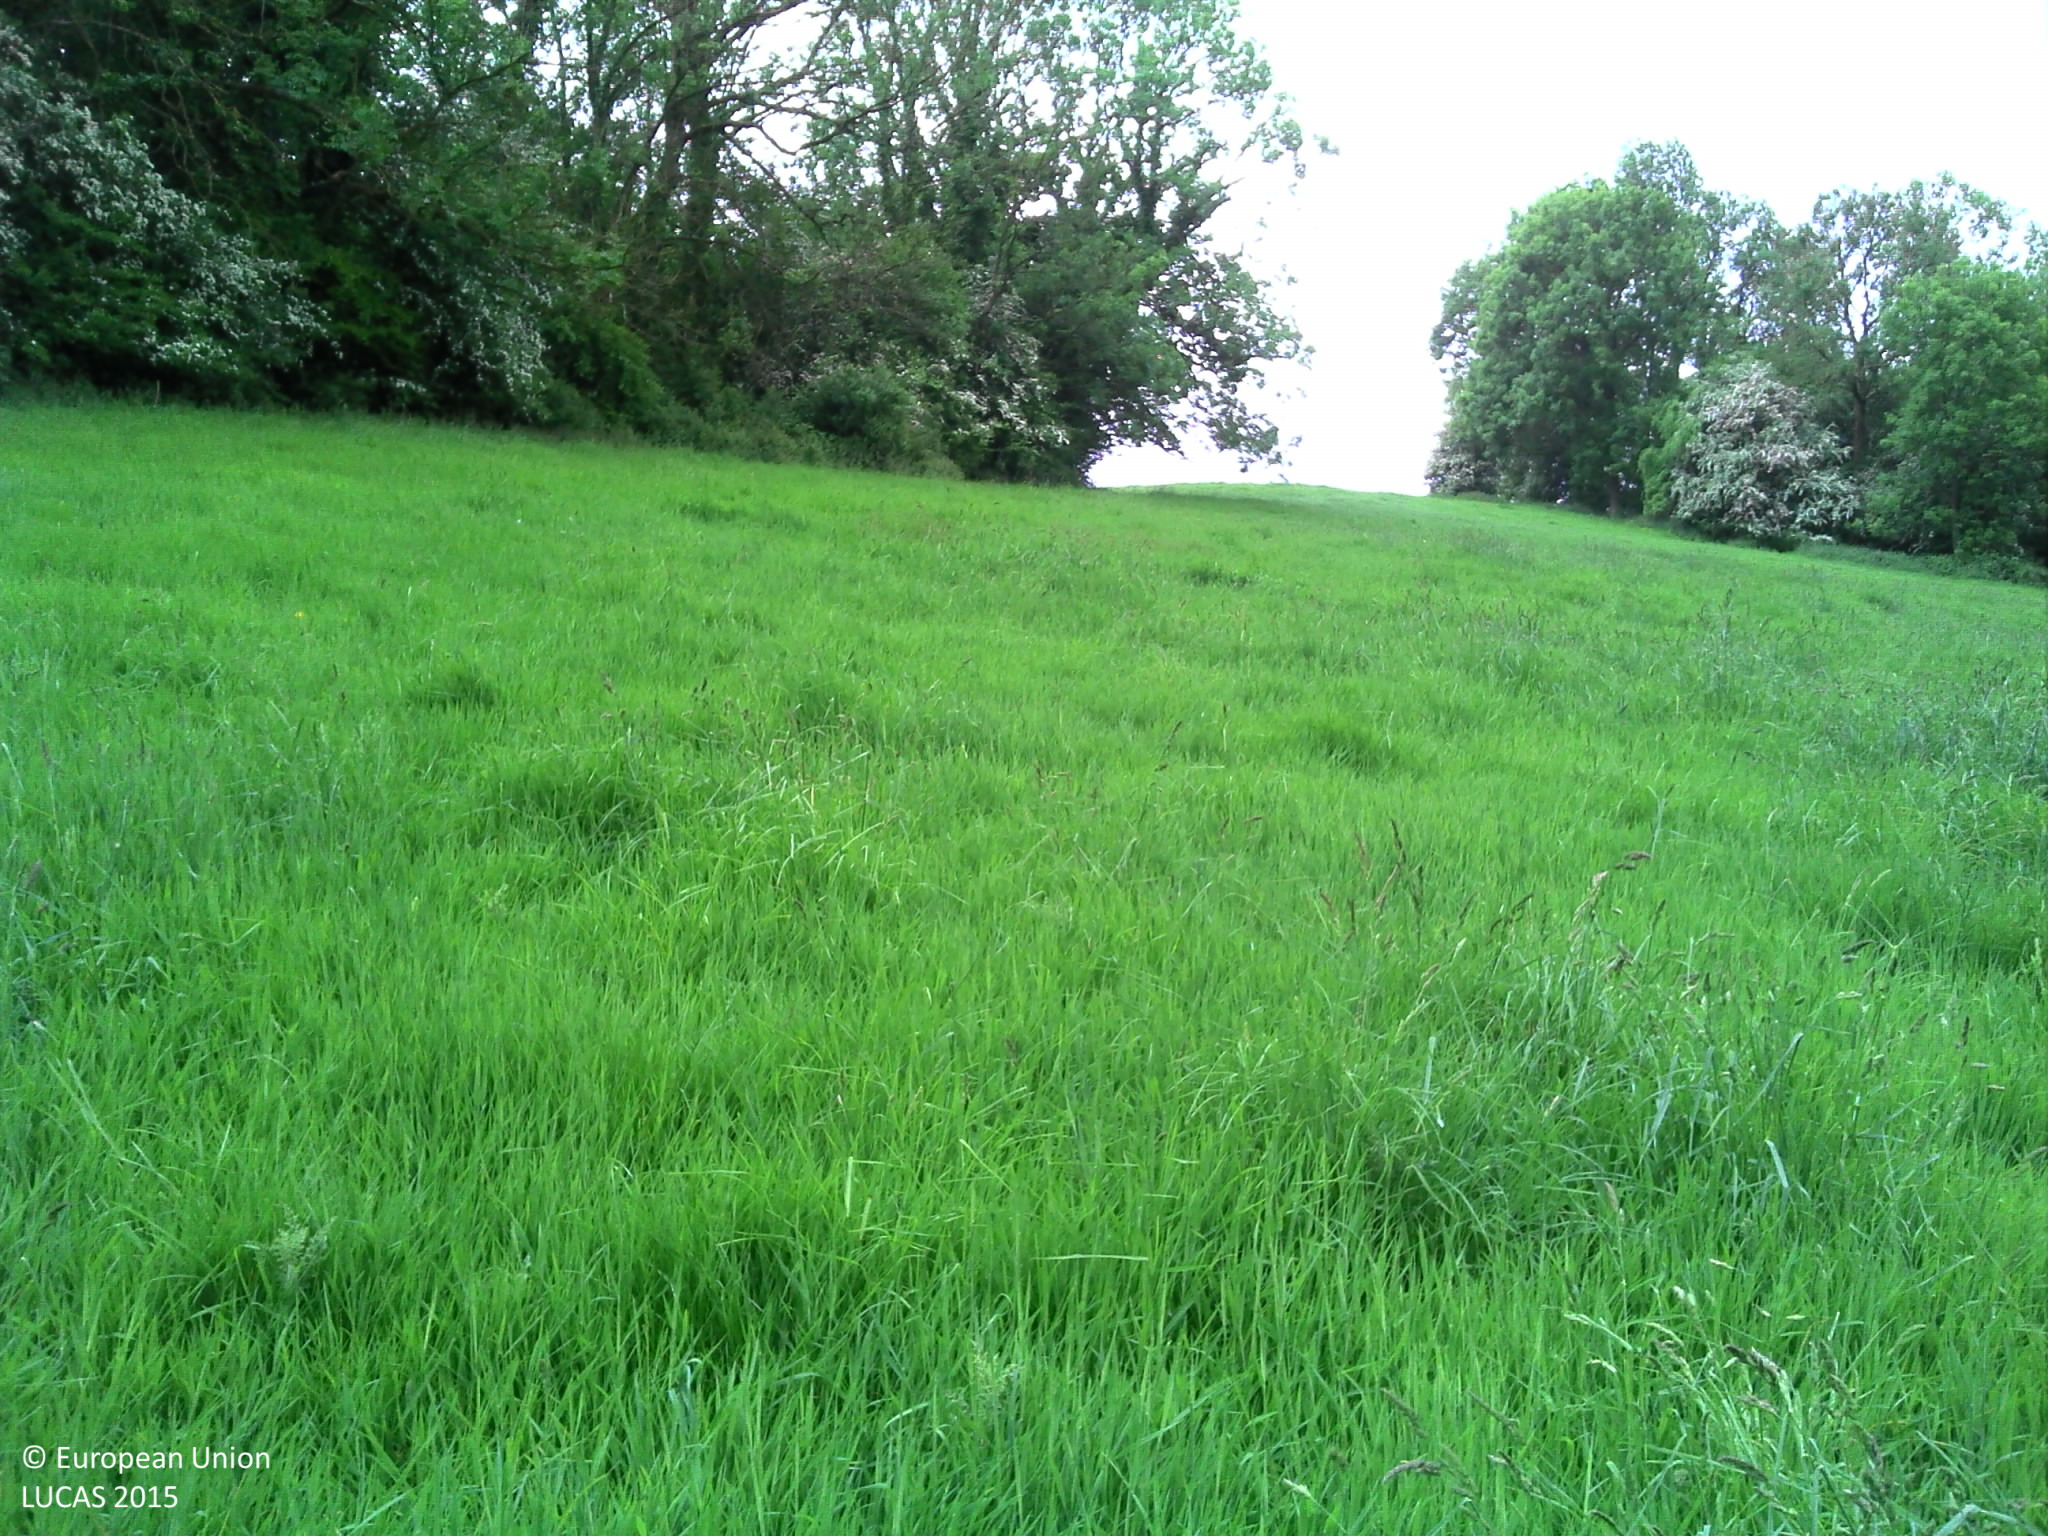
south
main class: Grassland
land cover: Grassland without tree/shrub cover
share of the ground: > 75 %
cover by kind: herbaceous plants 100 %
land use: Agriculture (excluding fallow land and kitchen gardens)
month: May
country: FR
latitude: 50.5063
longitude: 2.1029
